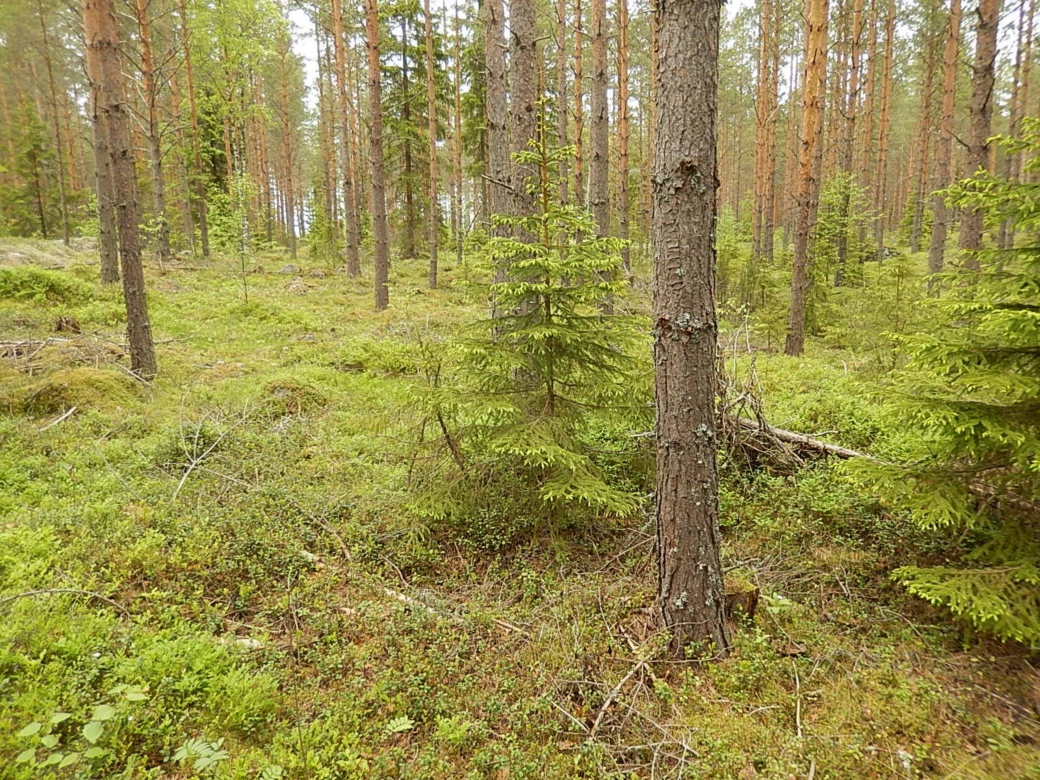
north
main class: Woodland
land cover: Pine dominated coniferous woodland
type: boreal forest
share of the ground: > 75 %
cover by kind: coniferous forest trees 70 %, shrubs 20 %, broadleaved forest trees 10 %
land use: Forestry
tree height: > 5 m
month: June
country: FI
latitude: 61.7648
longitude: 21.5506
